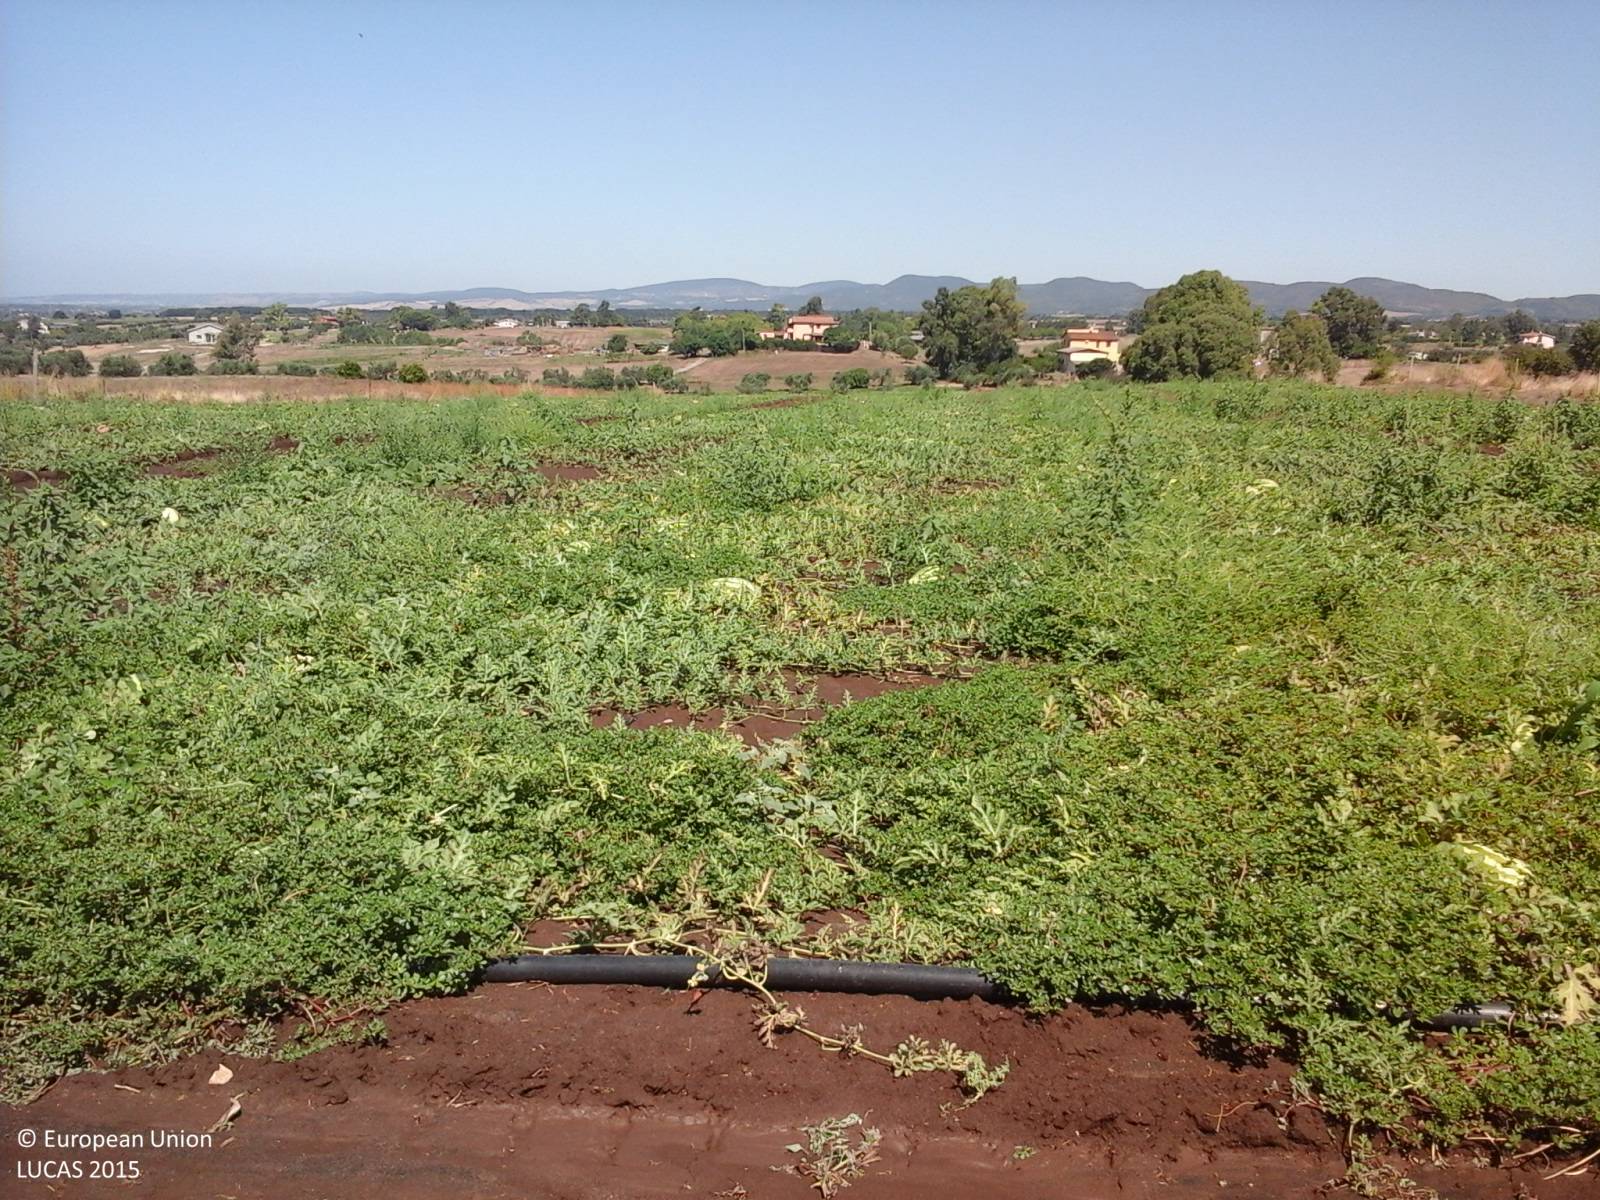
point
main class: Cropland
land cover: Other fresh vegetables
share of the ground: > 75 %
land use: Agriculture (excluding fallow land and kitchen gardens)
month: August
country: IT
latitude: 41.9625
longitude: 12.1517
